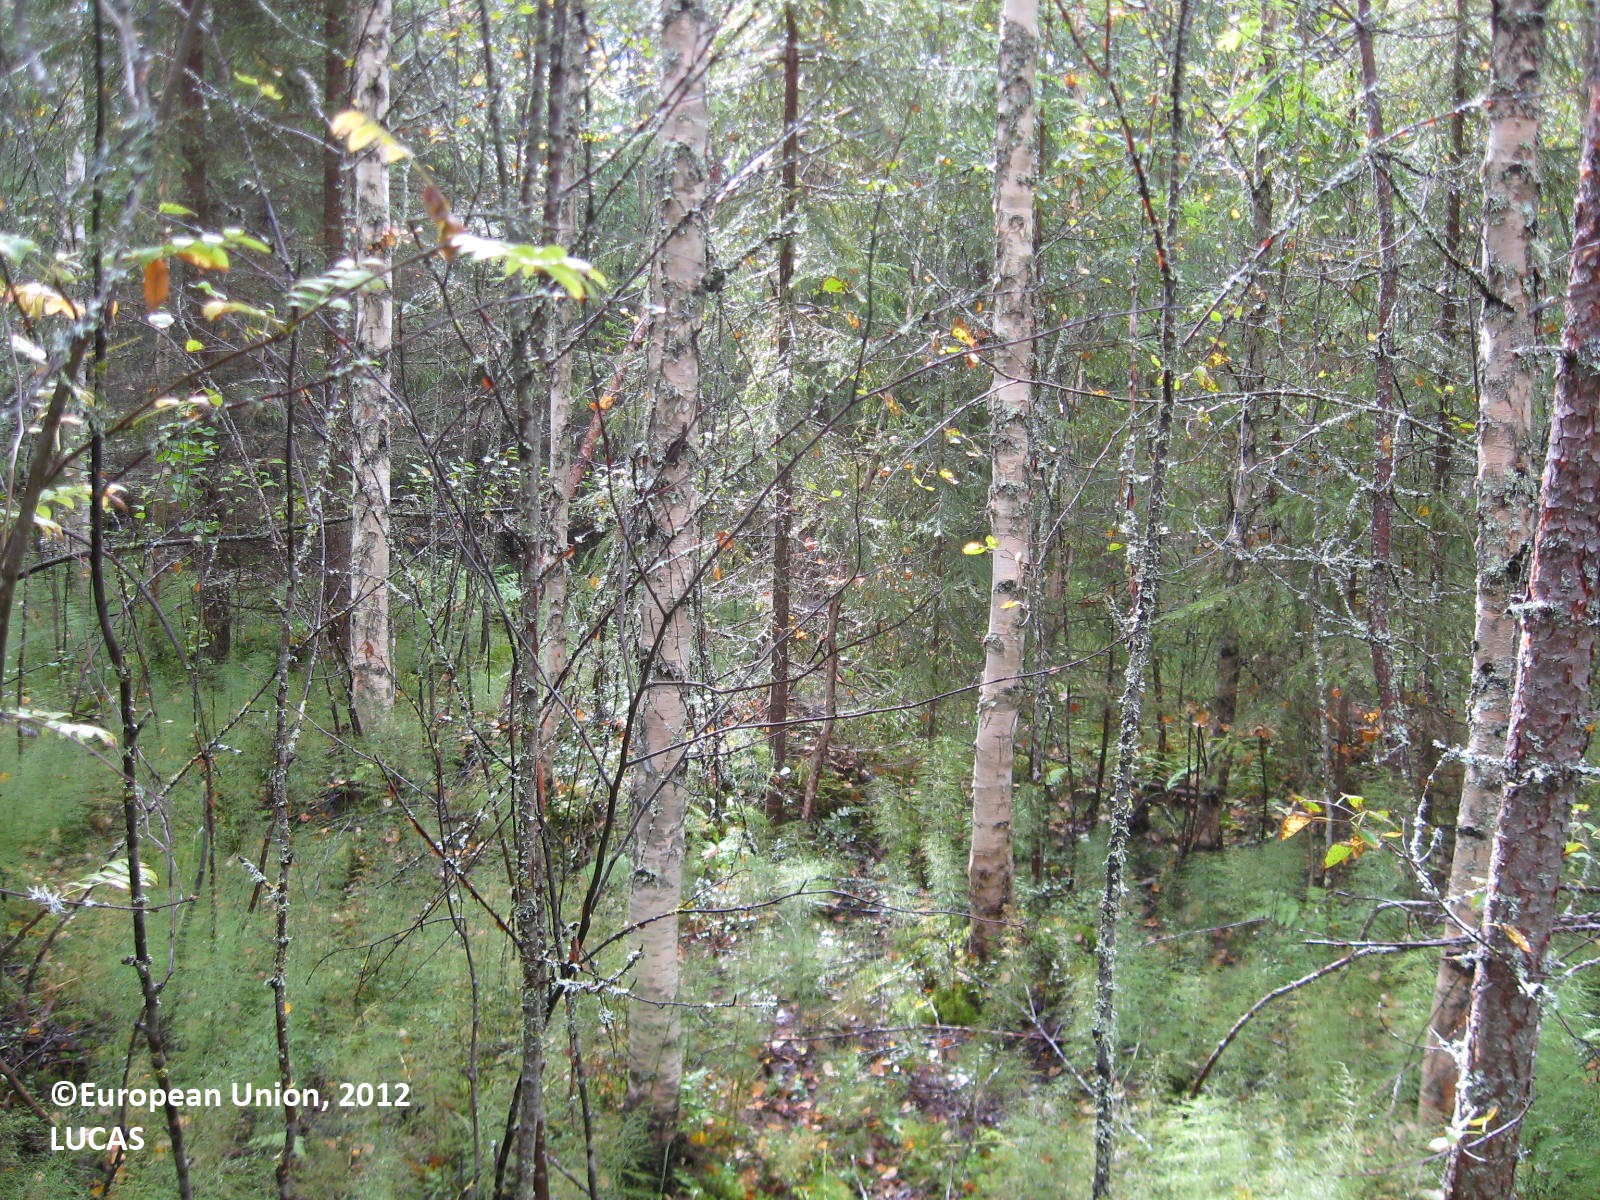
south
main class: Woodland
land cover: Other mixed woodland
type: boreal forest
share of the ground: > 75 %
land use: Forestry
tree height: > 5 m
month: August
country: FI
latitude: 63.4655
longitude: 29.8021
